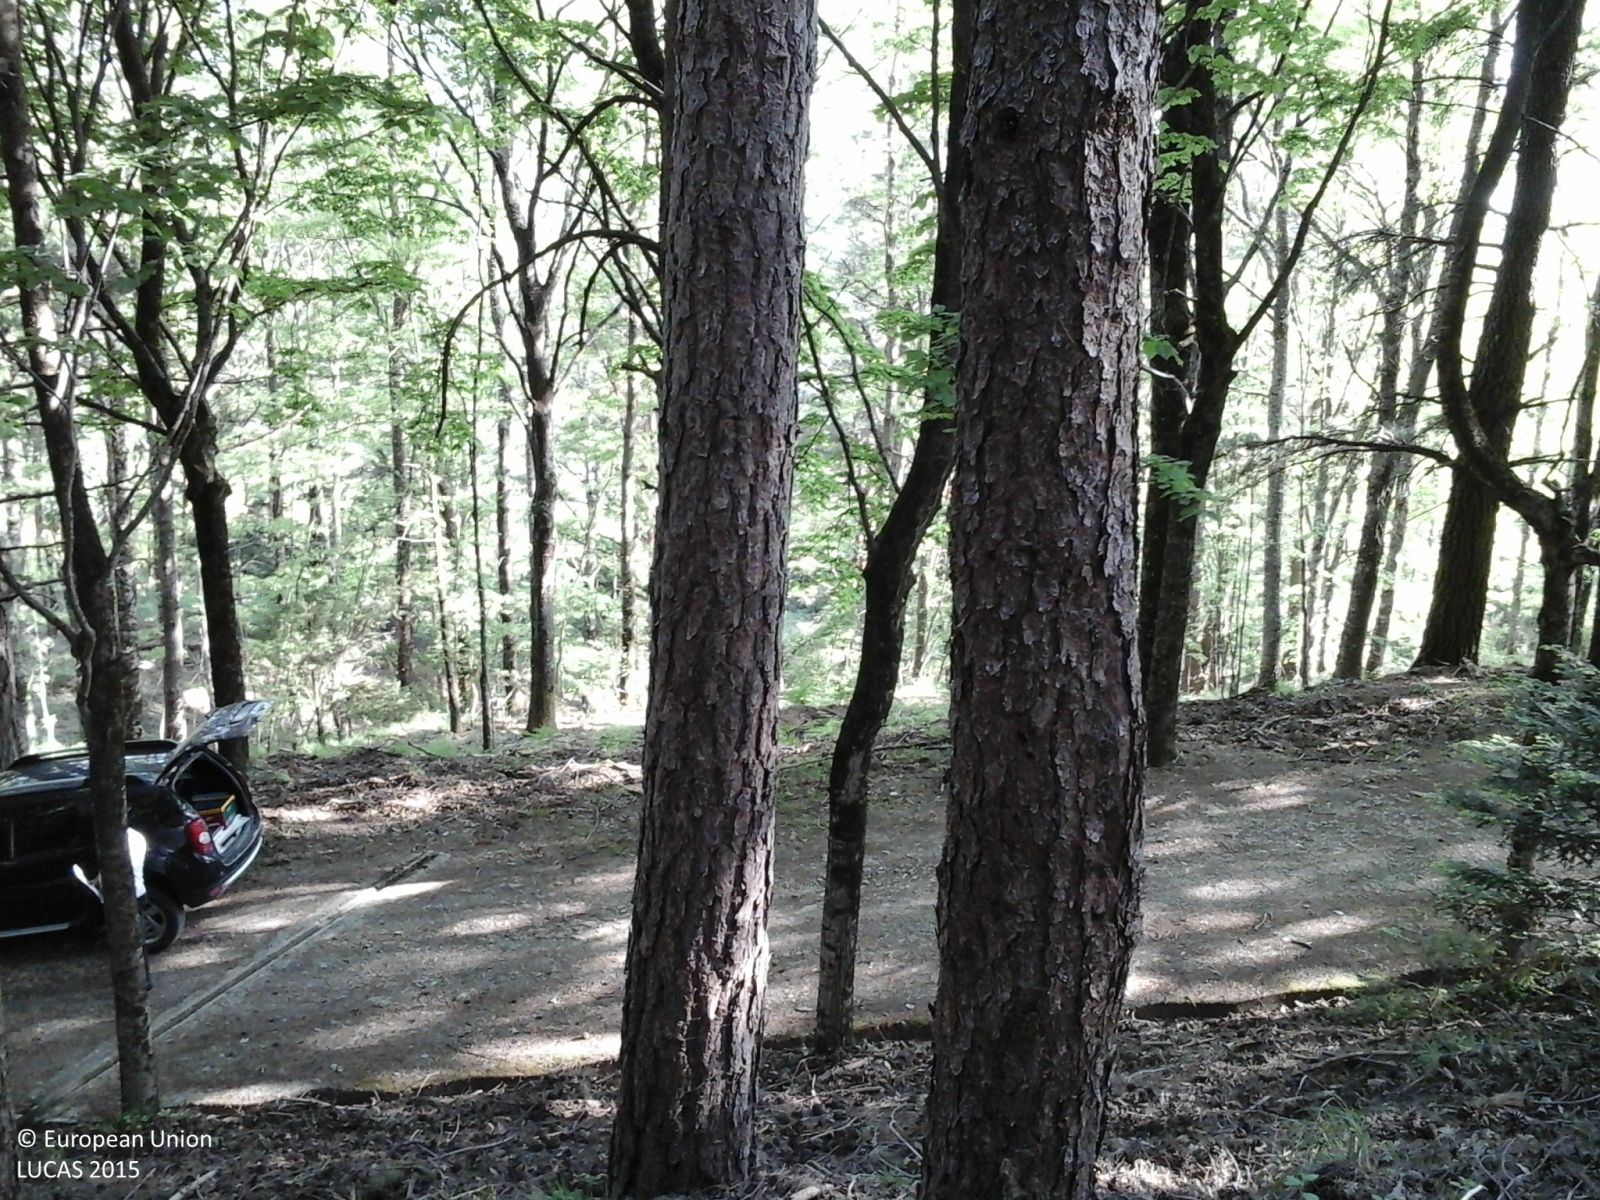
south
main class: Woodland
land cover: Pine dominated coniferous woodland
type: alpine coniferous forest
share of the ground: > 75 %
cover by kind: coniferous forest trees 100 %
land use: Forestry
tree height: > 5 m
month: May
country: IT
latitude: 43.7616
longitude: 11.5486
